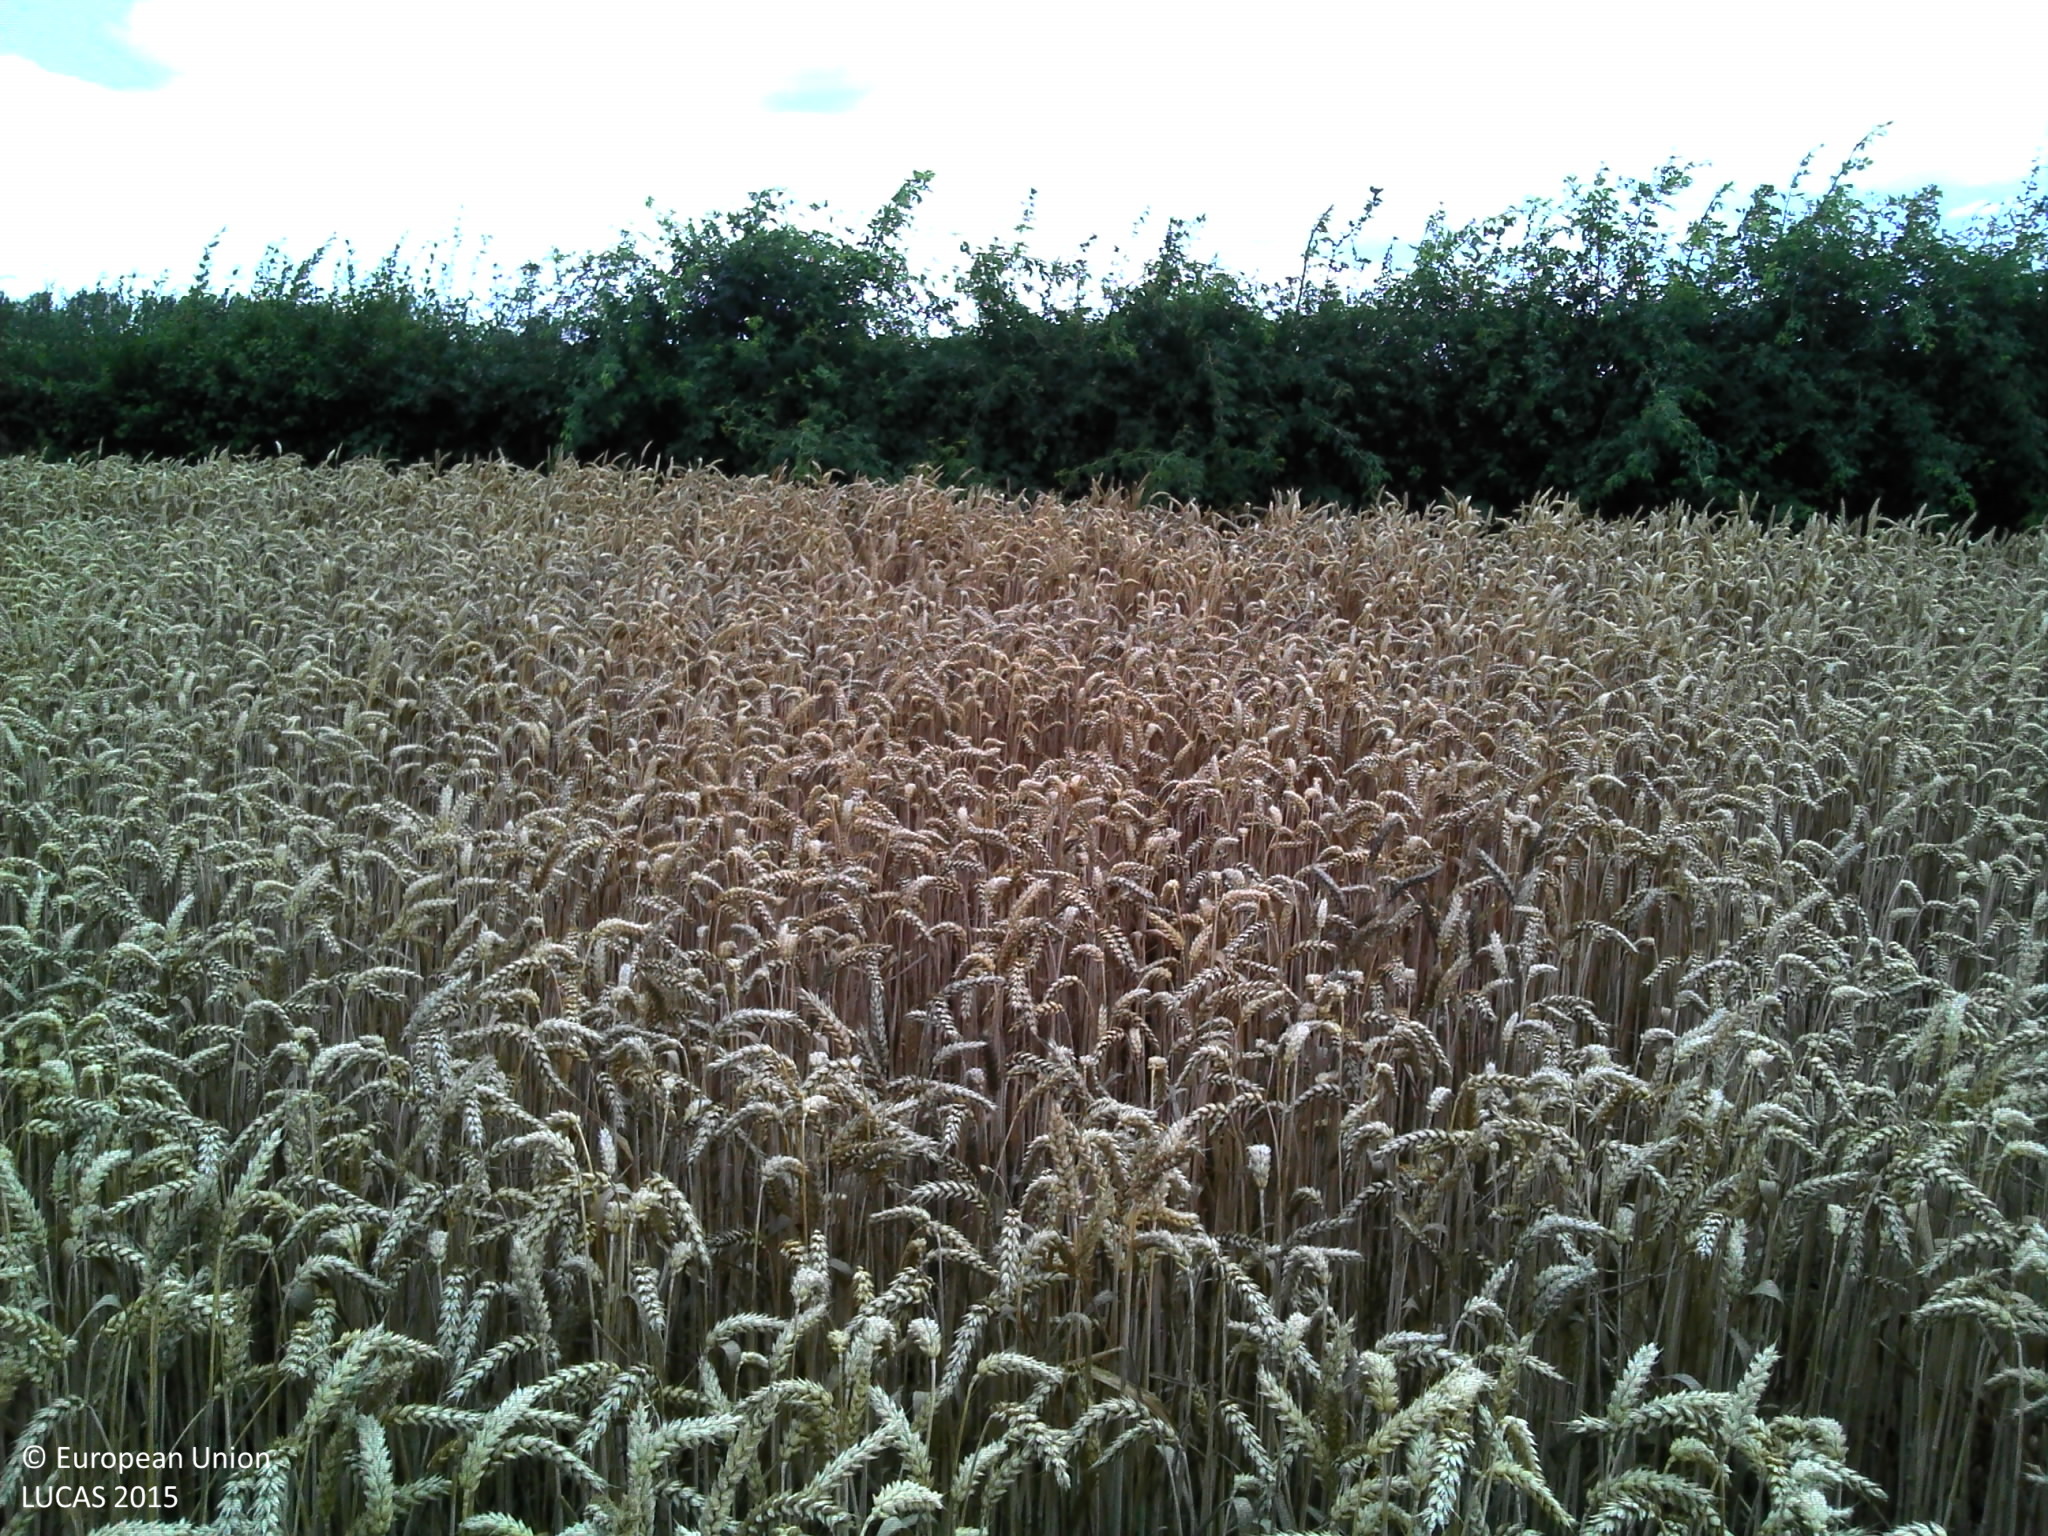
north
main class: Cropland
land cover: Common wheat
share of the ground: > 75 %
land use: Agriculture (excluding fallow land and kitchen gardens)
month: July
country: FR
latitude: 50.1322
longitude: 3.6277
